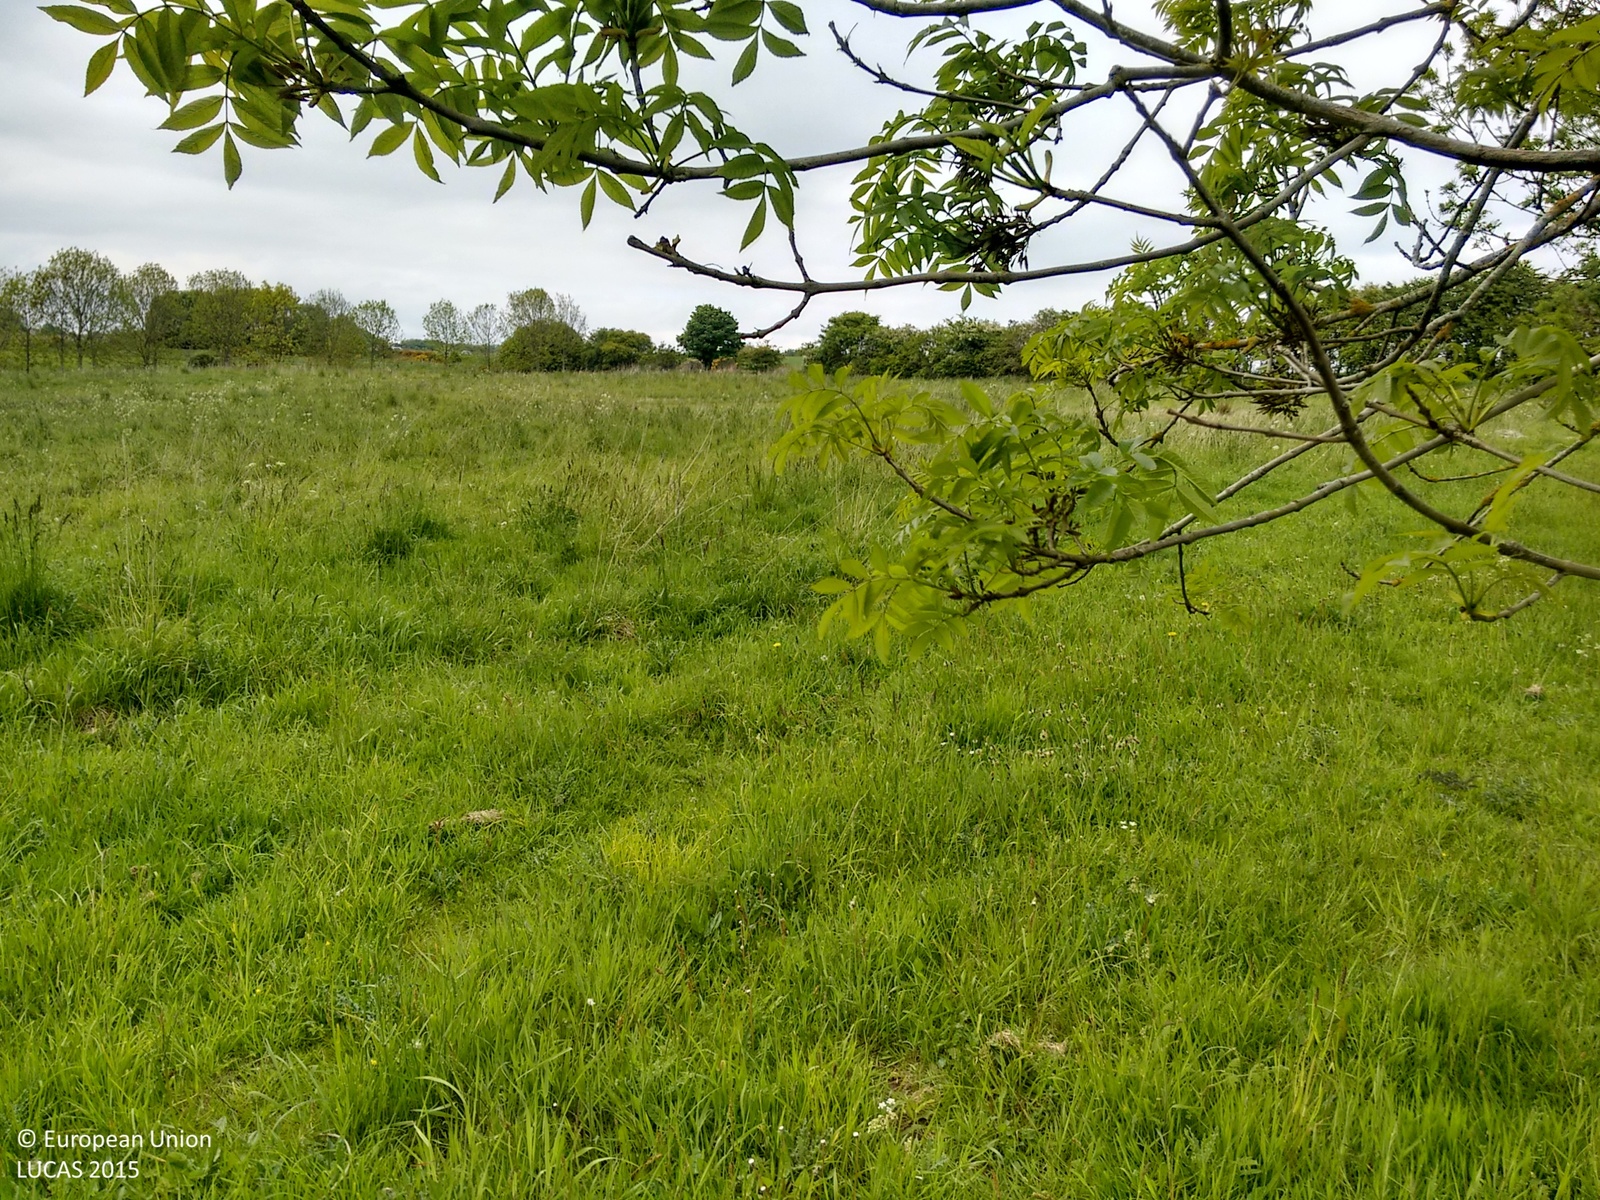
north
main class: Woodland
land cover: Broadleaved woodland
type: mesophytic deciduous forest
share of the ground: > 75 %
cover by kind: broadleaved forest trees 80 %, herbaceous plants 20 %
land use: Semi-natural and natural areas not in use
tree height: > 5 m
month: June
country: GB
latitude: 57.2779
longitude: -2.2071
